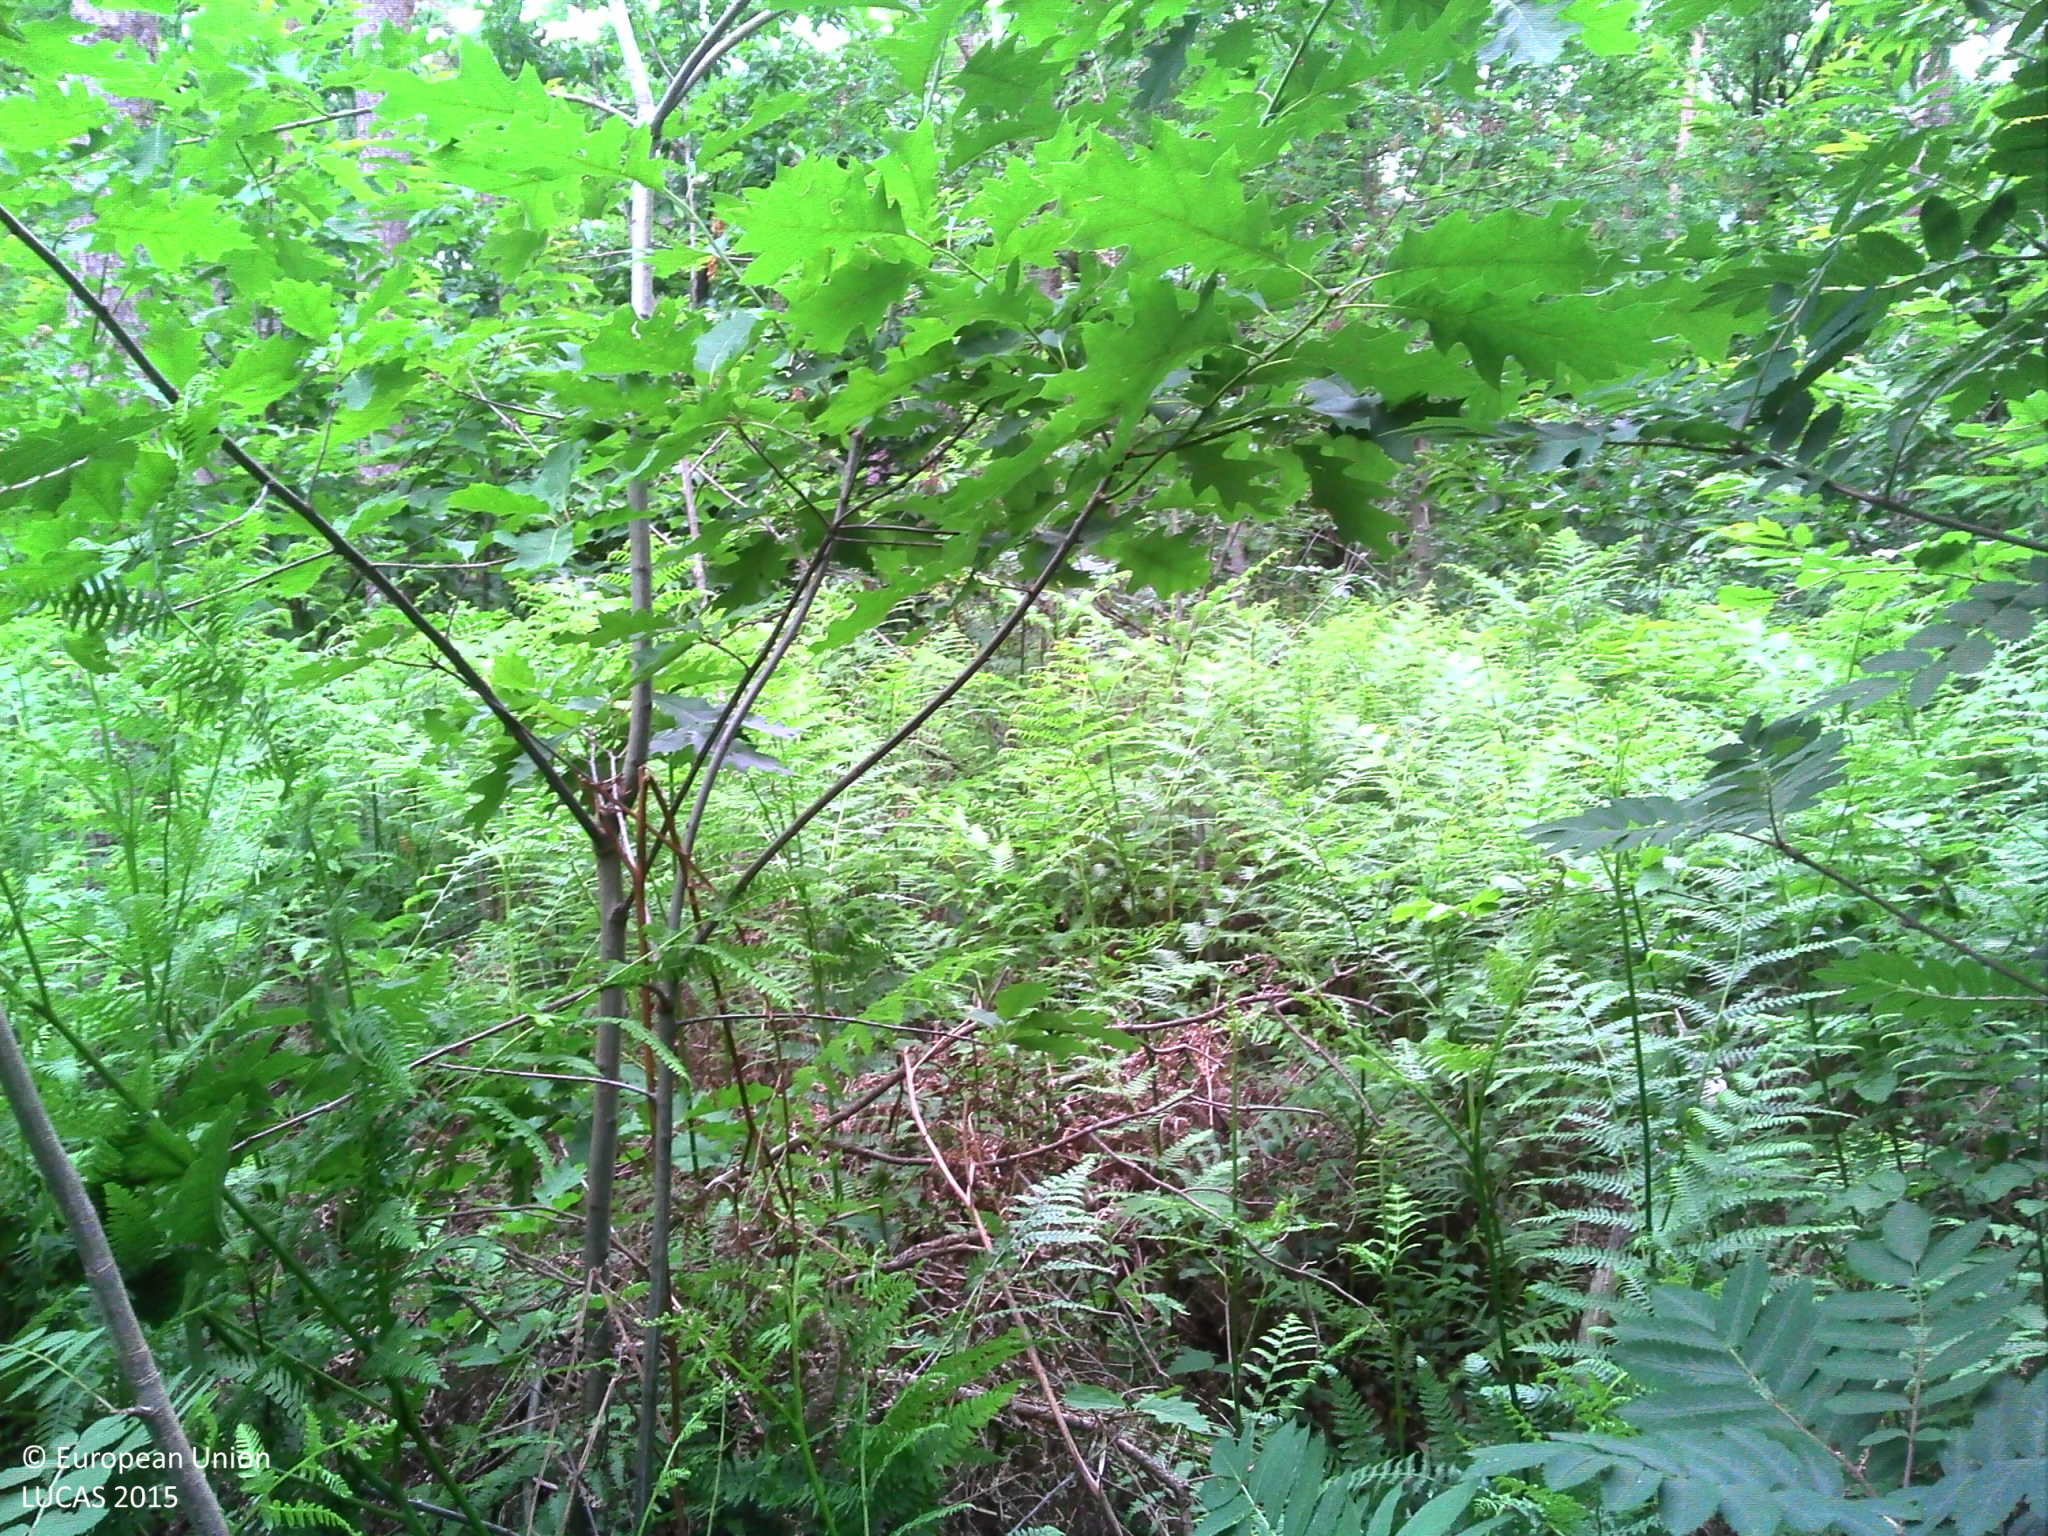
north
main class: Woodland
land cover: Pine dominated mixed woodland
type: acidophilous oak and oak-birch forest
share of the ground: > 75 %
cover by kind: broadleaved forest trees 40 %, shrubs 35 %, coniferous forest trees 20 %, herbaceous plants 5 %
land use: Forestry
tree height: > 5 m
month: June
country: BE
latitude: 50.8526
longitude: 2.9869
